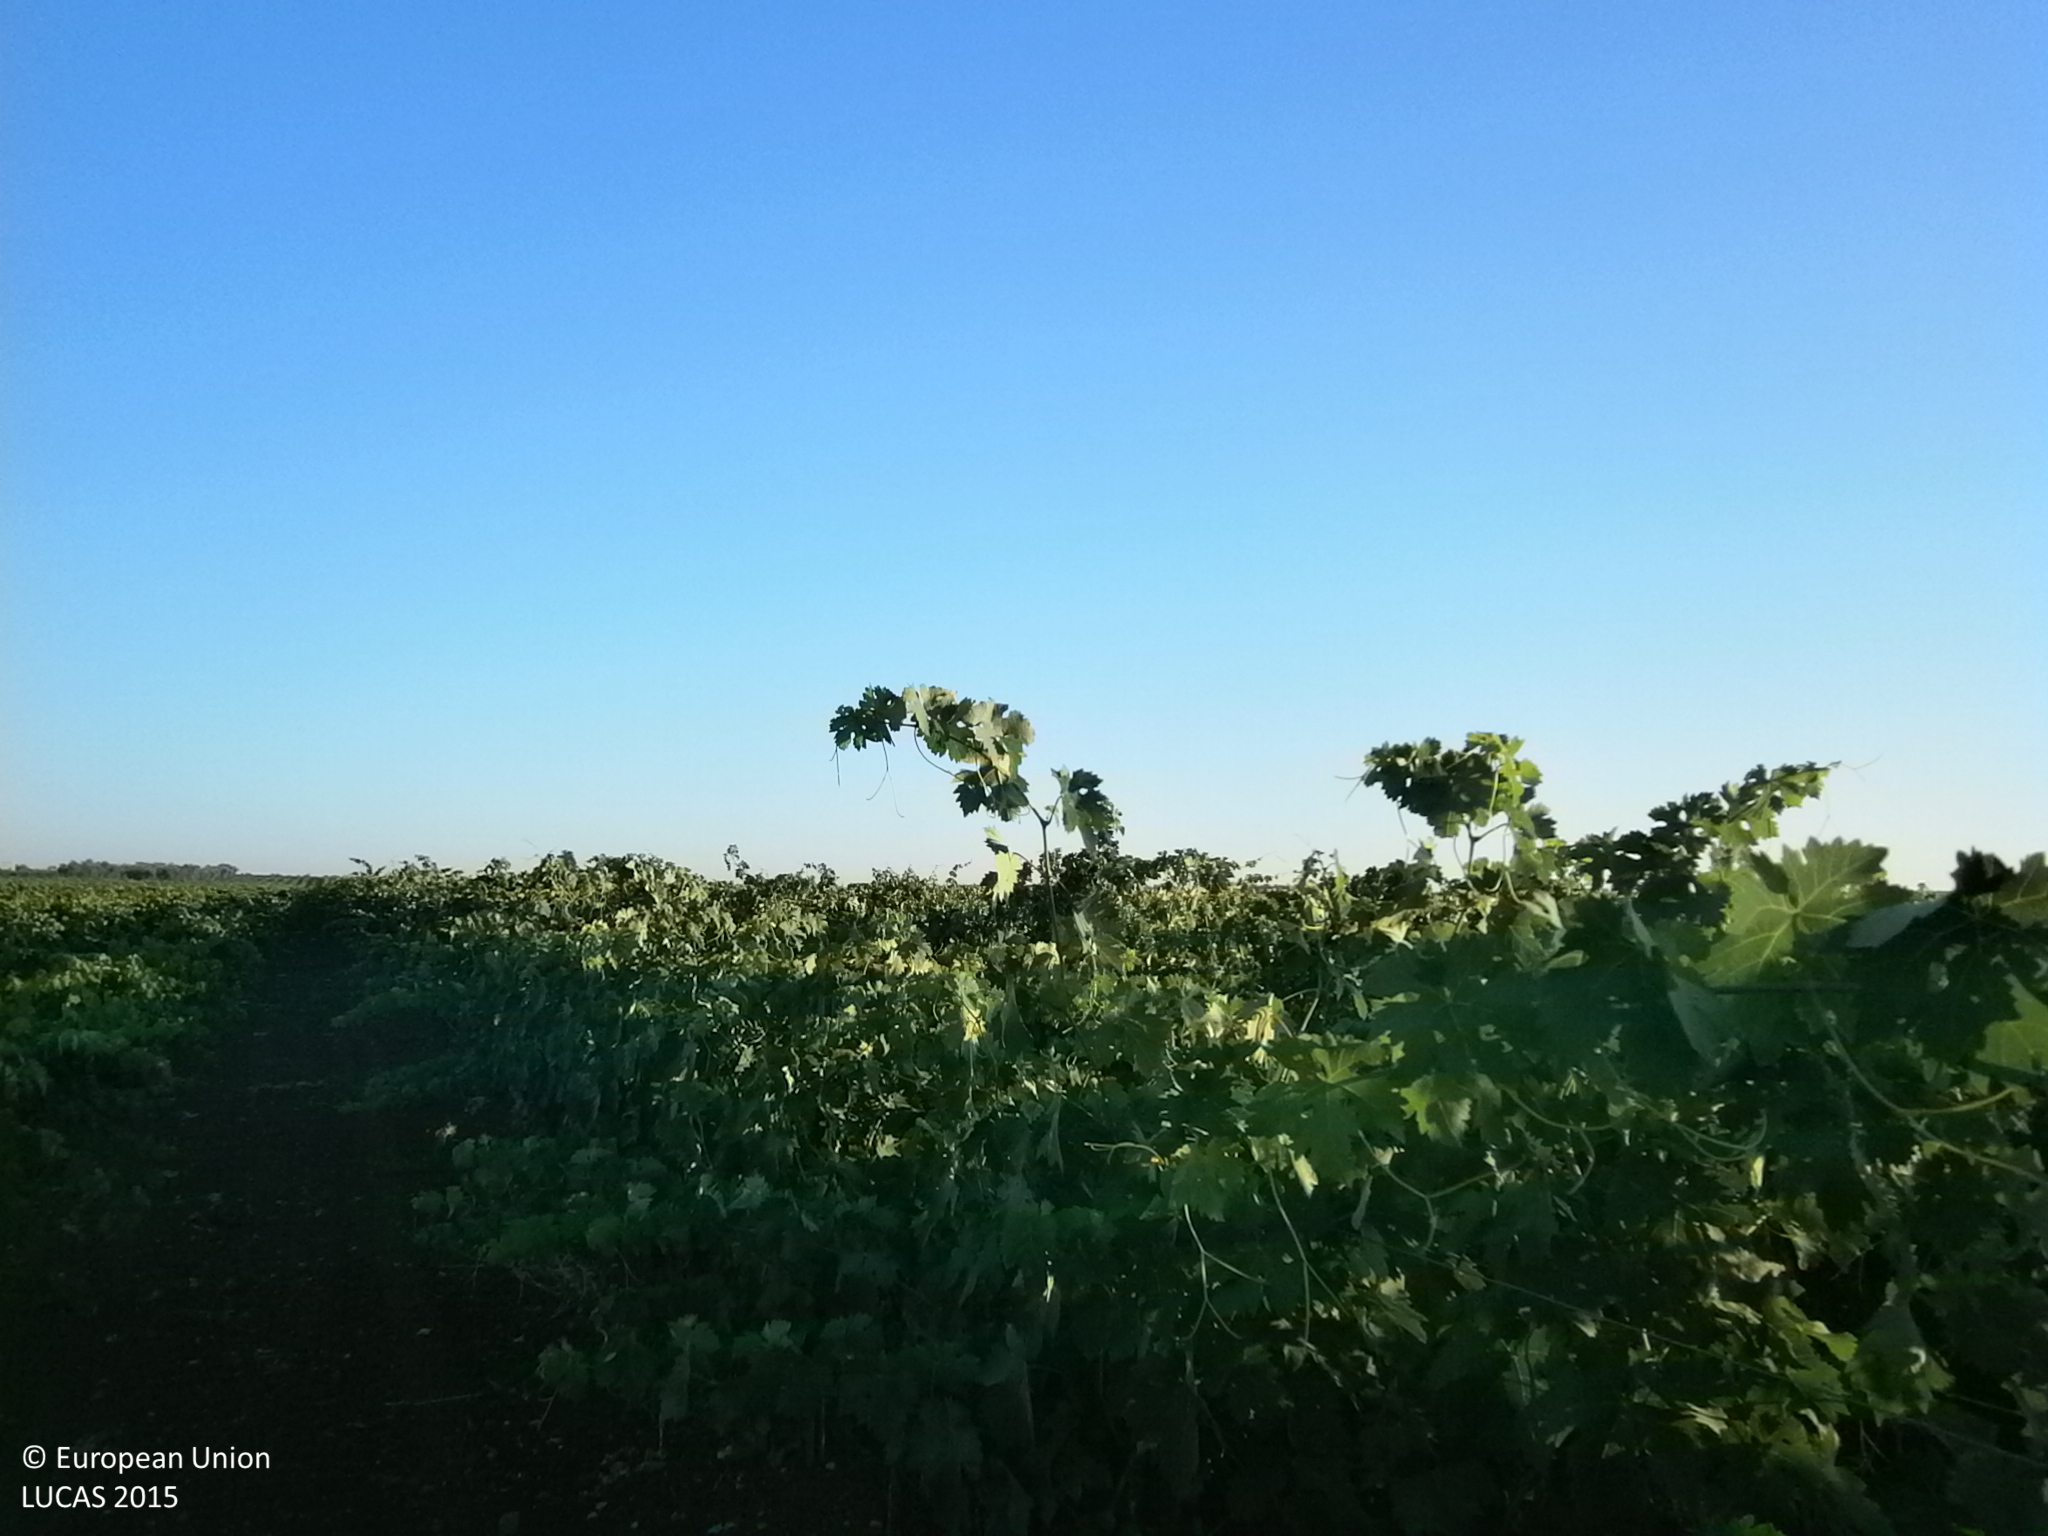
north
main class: Cropland
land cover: Vineyards
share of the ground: 25 - 50 %
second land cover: Other bare soil
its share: > 75 %
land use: Agriculture (excluding fallow land and kitchen gardens)
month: June
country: ES
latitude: 38.7075
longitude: -6.4192
